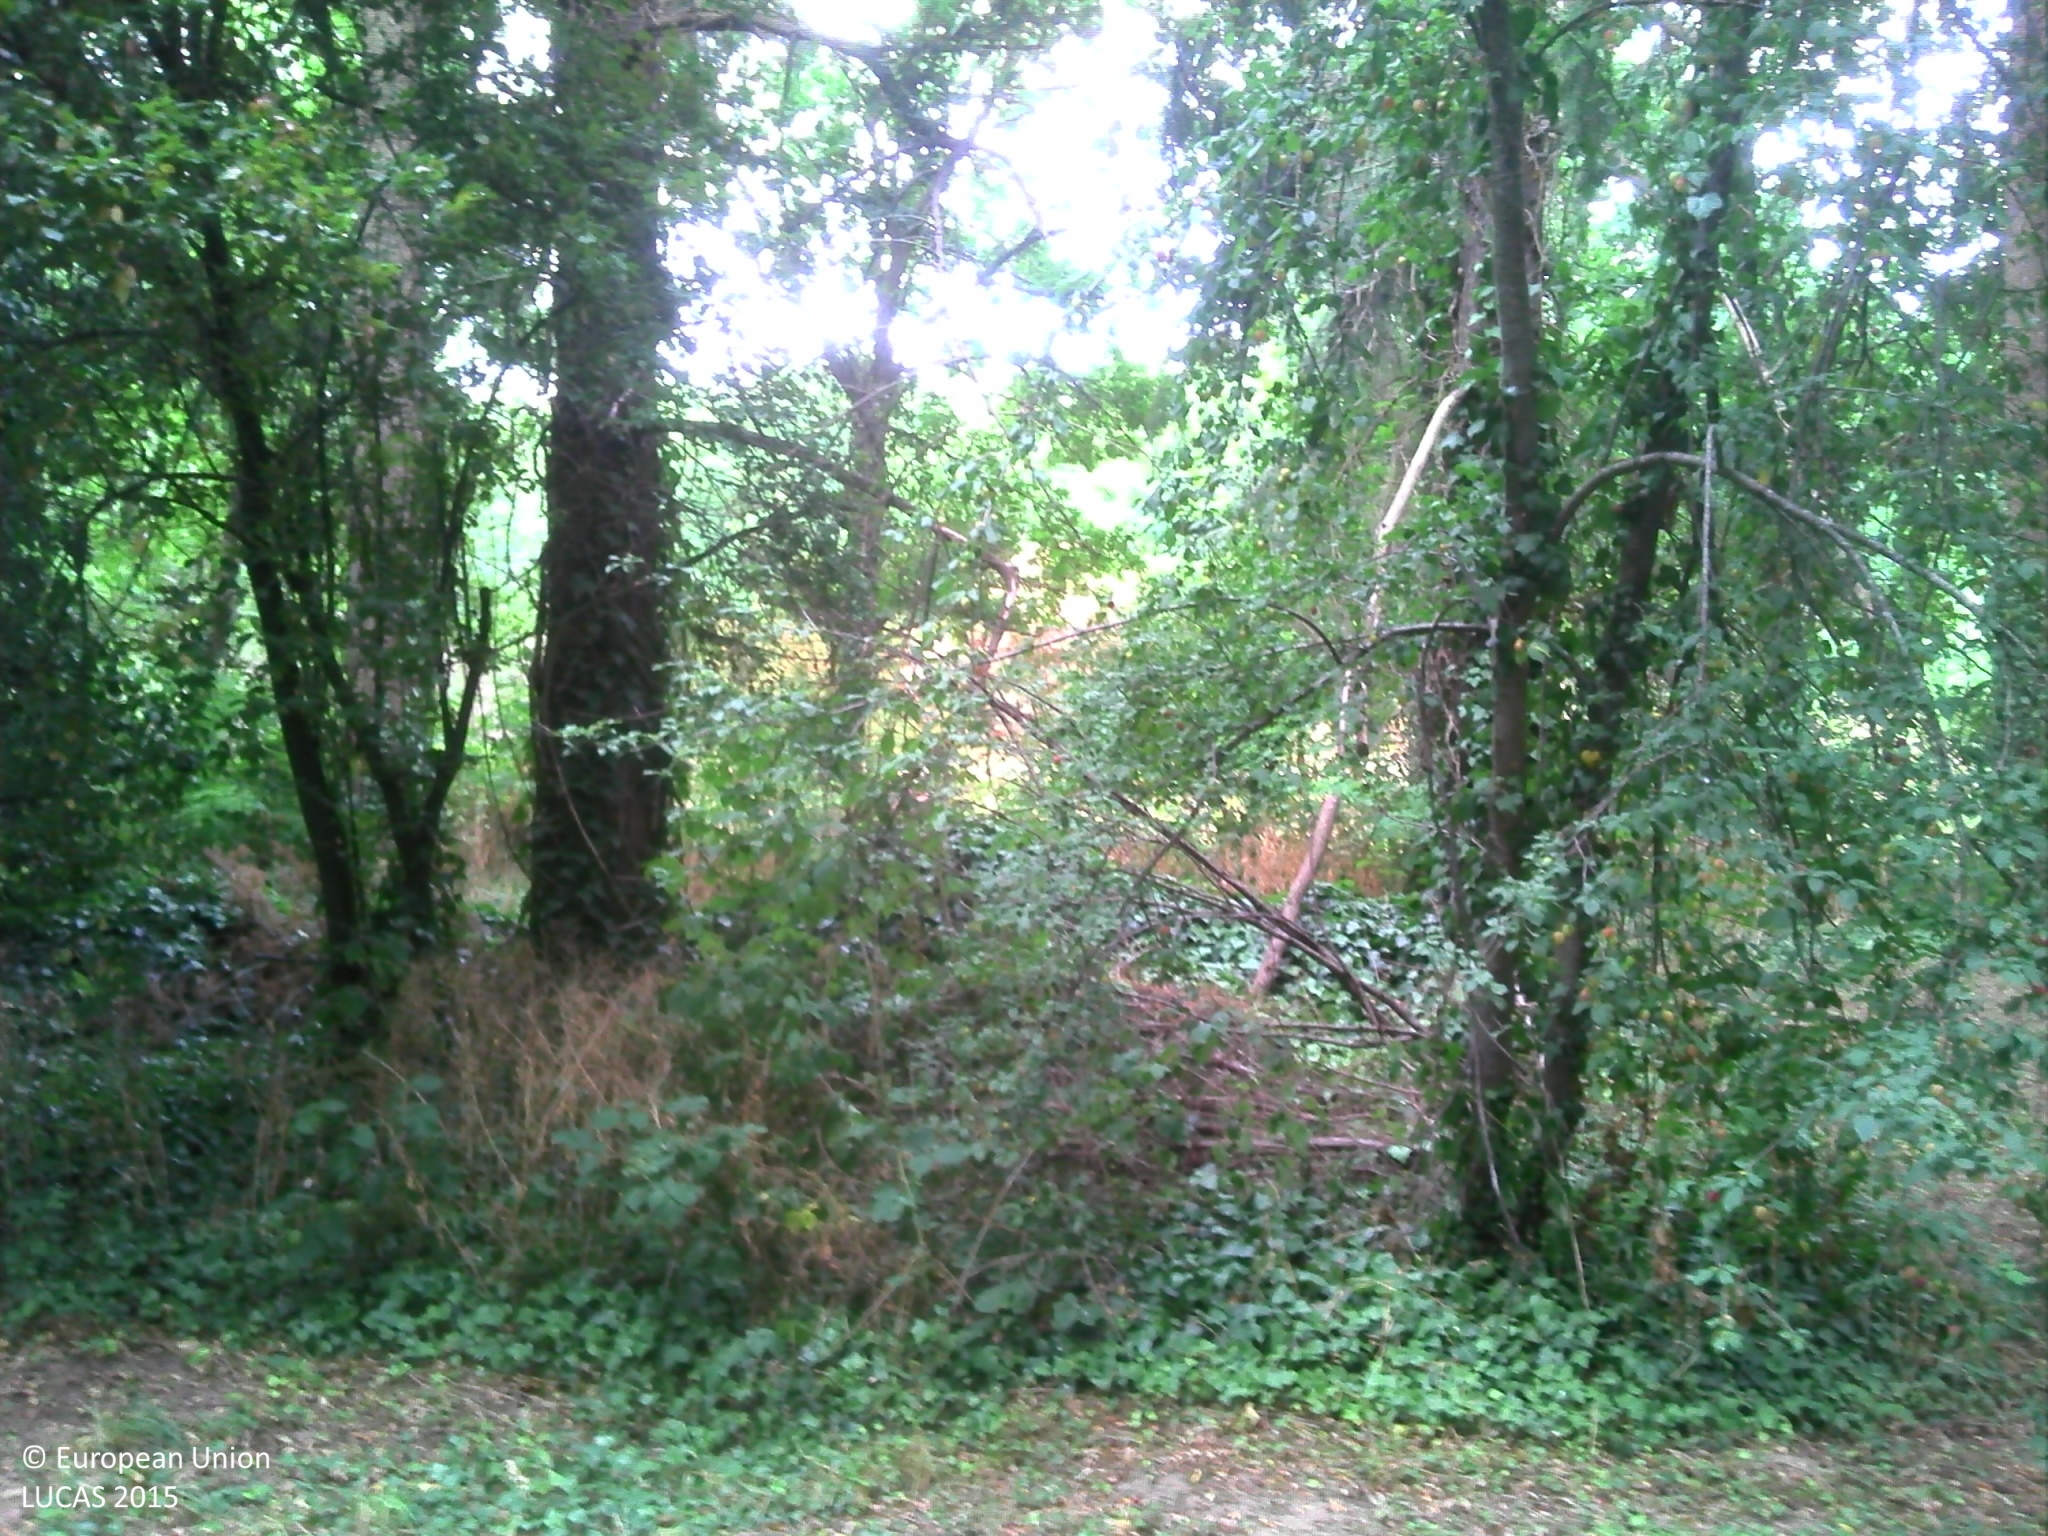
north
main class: Woodland
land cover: Other mixed woodland
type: hemiboreal forest and nemoral coniferous forest and mixed broadleaved-coniferous forest
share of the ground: > 75 %
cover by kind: coniferous forest trees 45 %, herbaceous plants 30 %, broadleaved forest trees 25 %
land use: Forestry
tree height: > 5 m
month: July
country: FR
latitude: 46.8456
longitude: 4.9526
